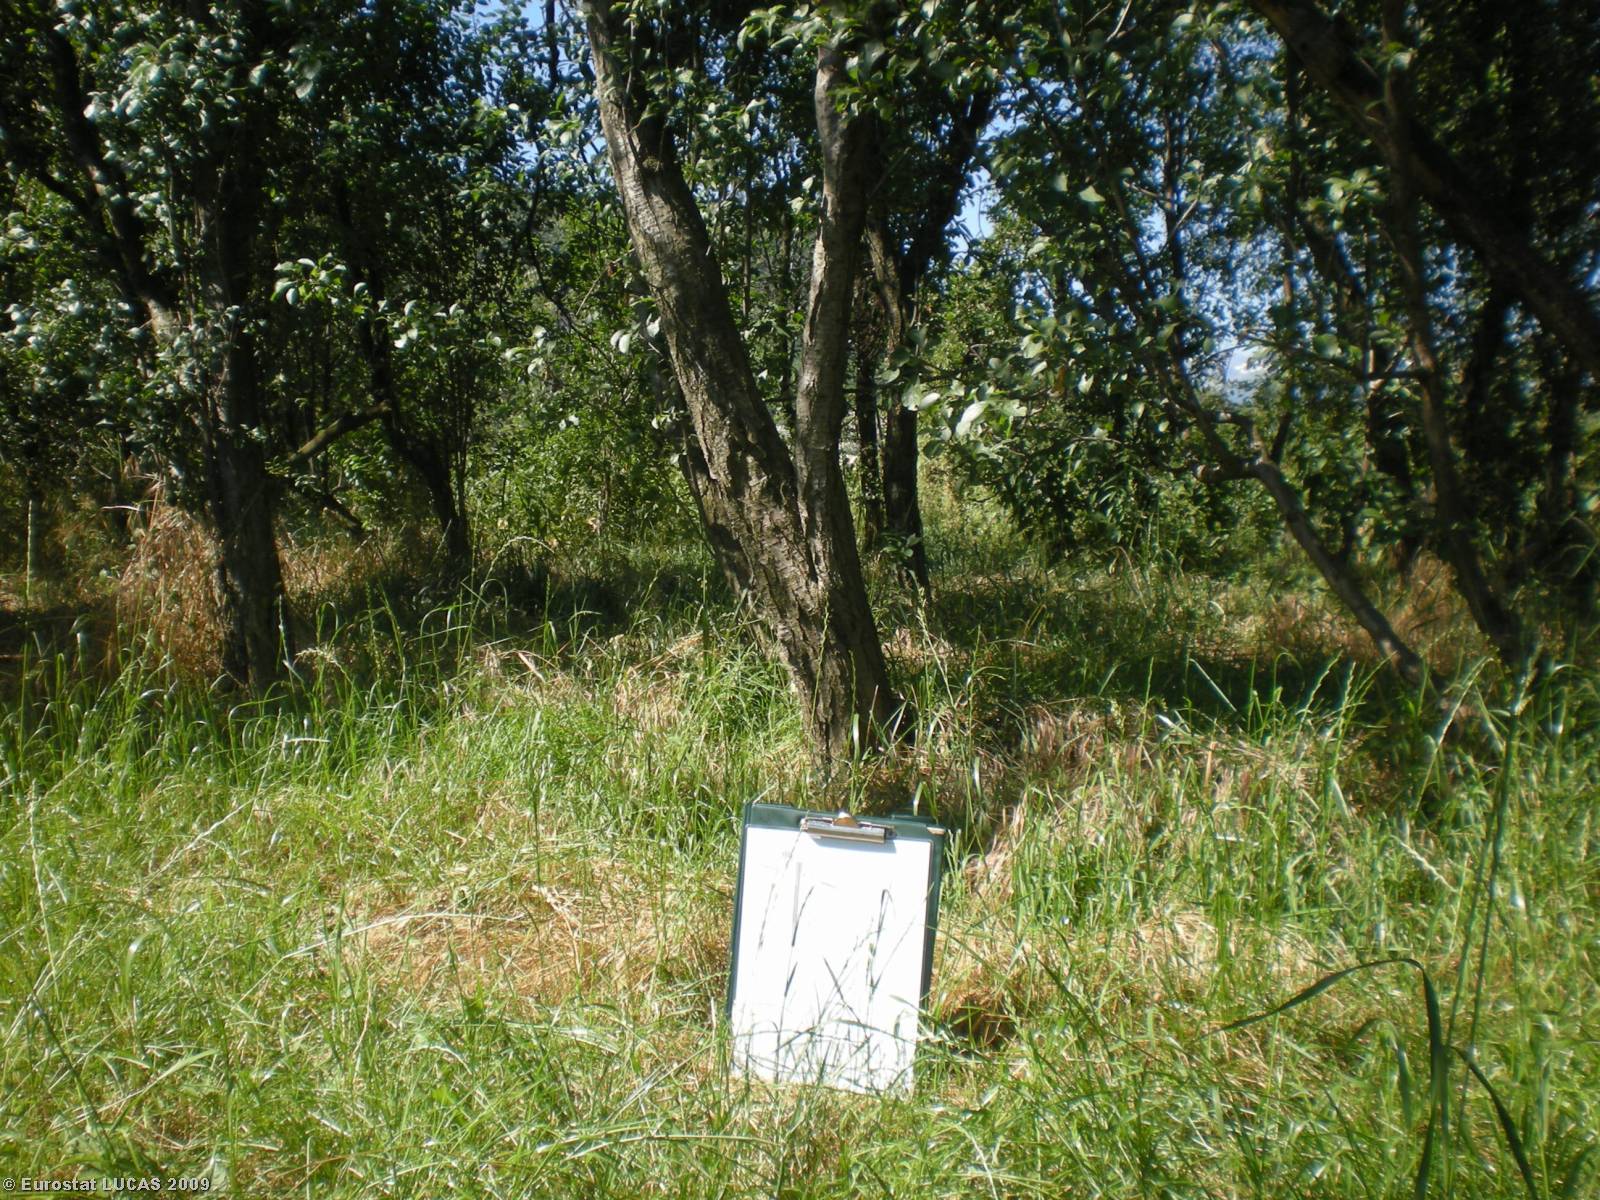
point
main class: Cropland
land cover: Other fruit trees and berries
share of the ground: 50 - 75 %
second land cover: Grassland with sparse tree/shrub cover
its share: > 75 %
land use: Agriculture (excluding fallow land and kitchen gardens)
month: June
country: IT
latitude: 44.7315
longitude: 7.3407
